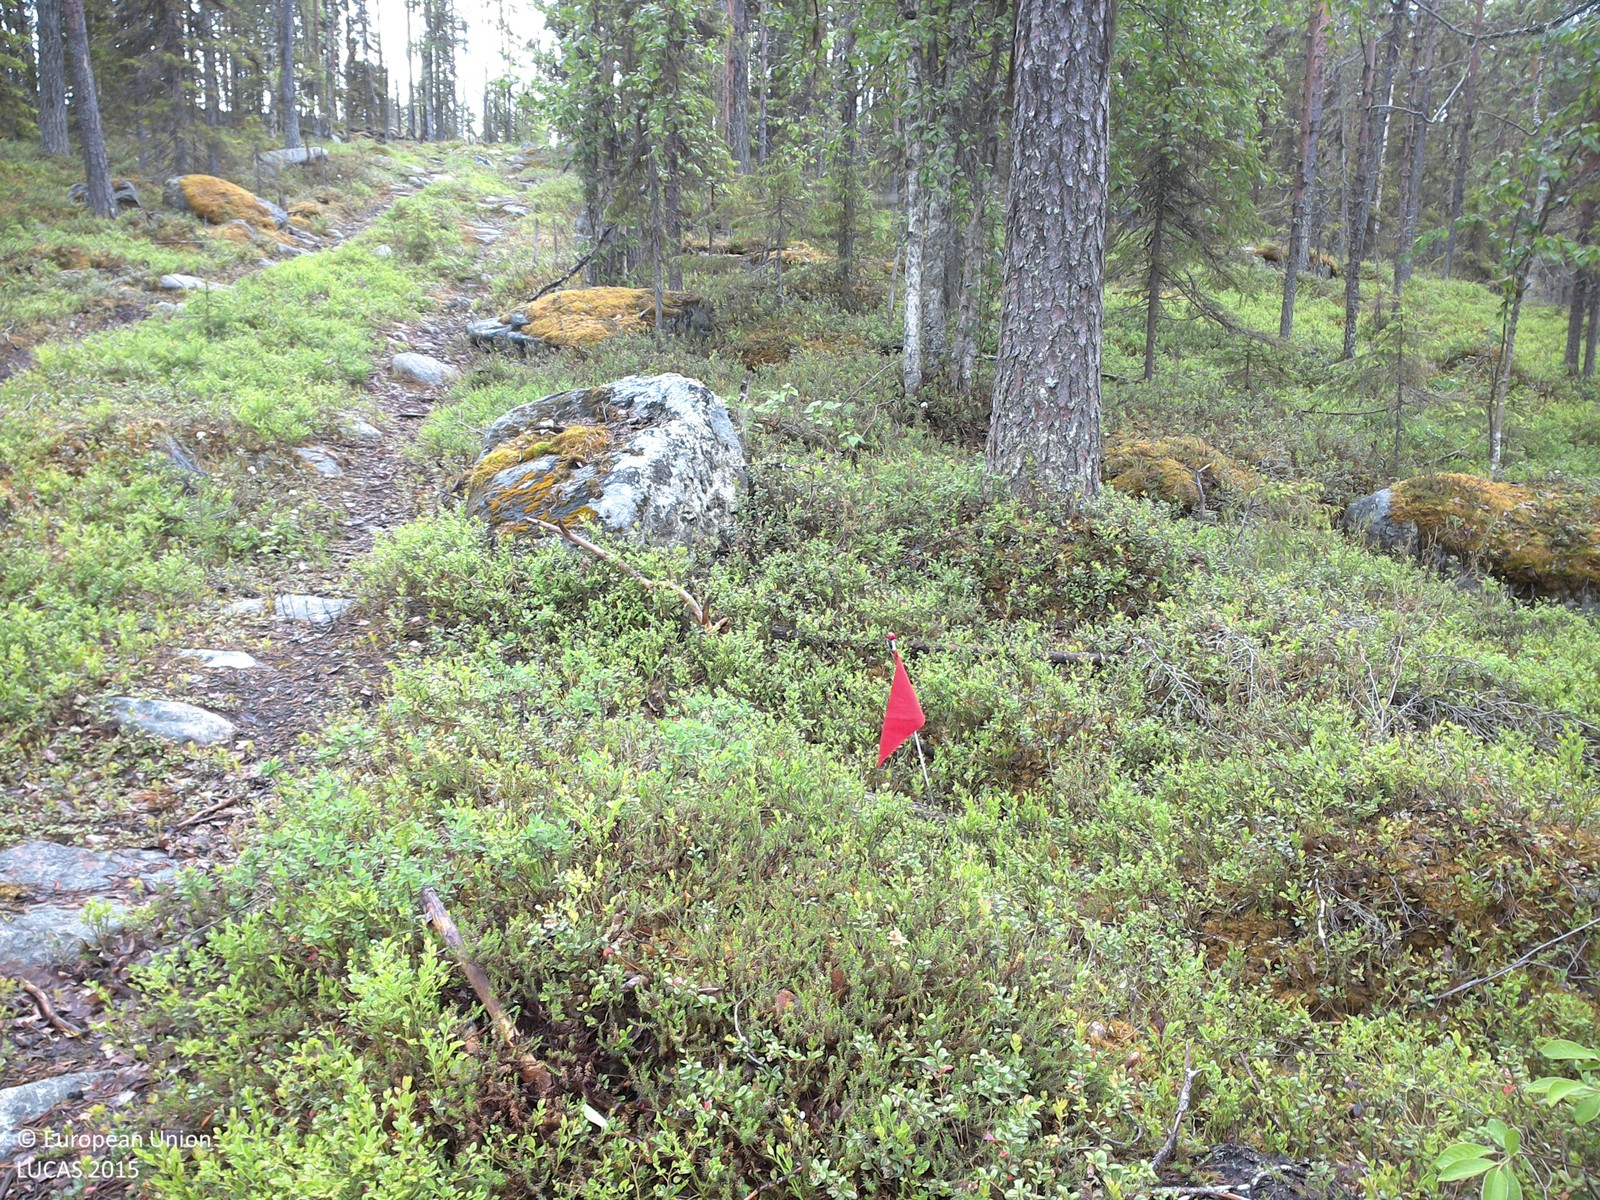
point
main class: Woodland
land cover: Pine dominated mixed woodland
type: boreal forest
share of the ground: 25 - 50 %
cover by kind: shrubs 70 %, coniferous forest trees 15 %, broadleaved forest trees 10 %, unconsolidated bare surface 5 %
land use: Forestry
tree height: > 5 m
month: July
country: SE
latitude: 66.7591
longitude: 23.0785
